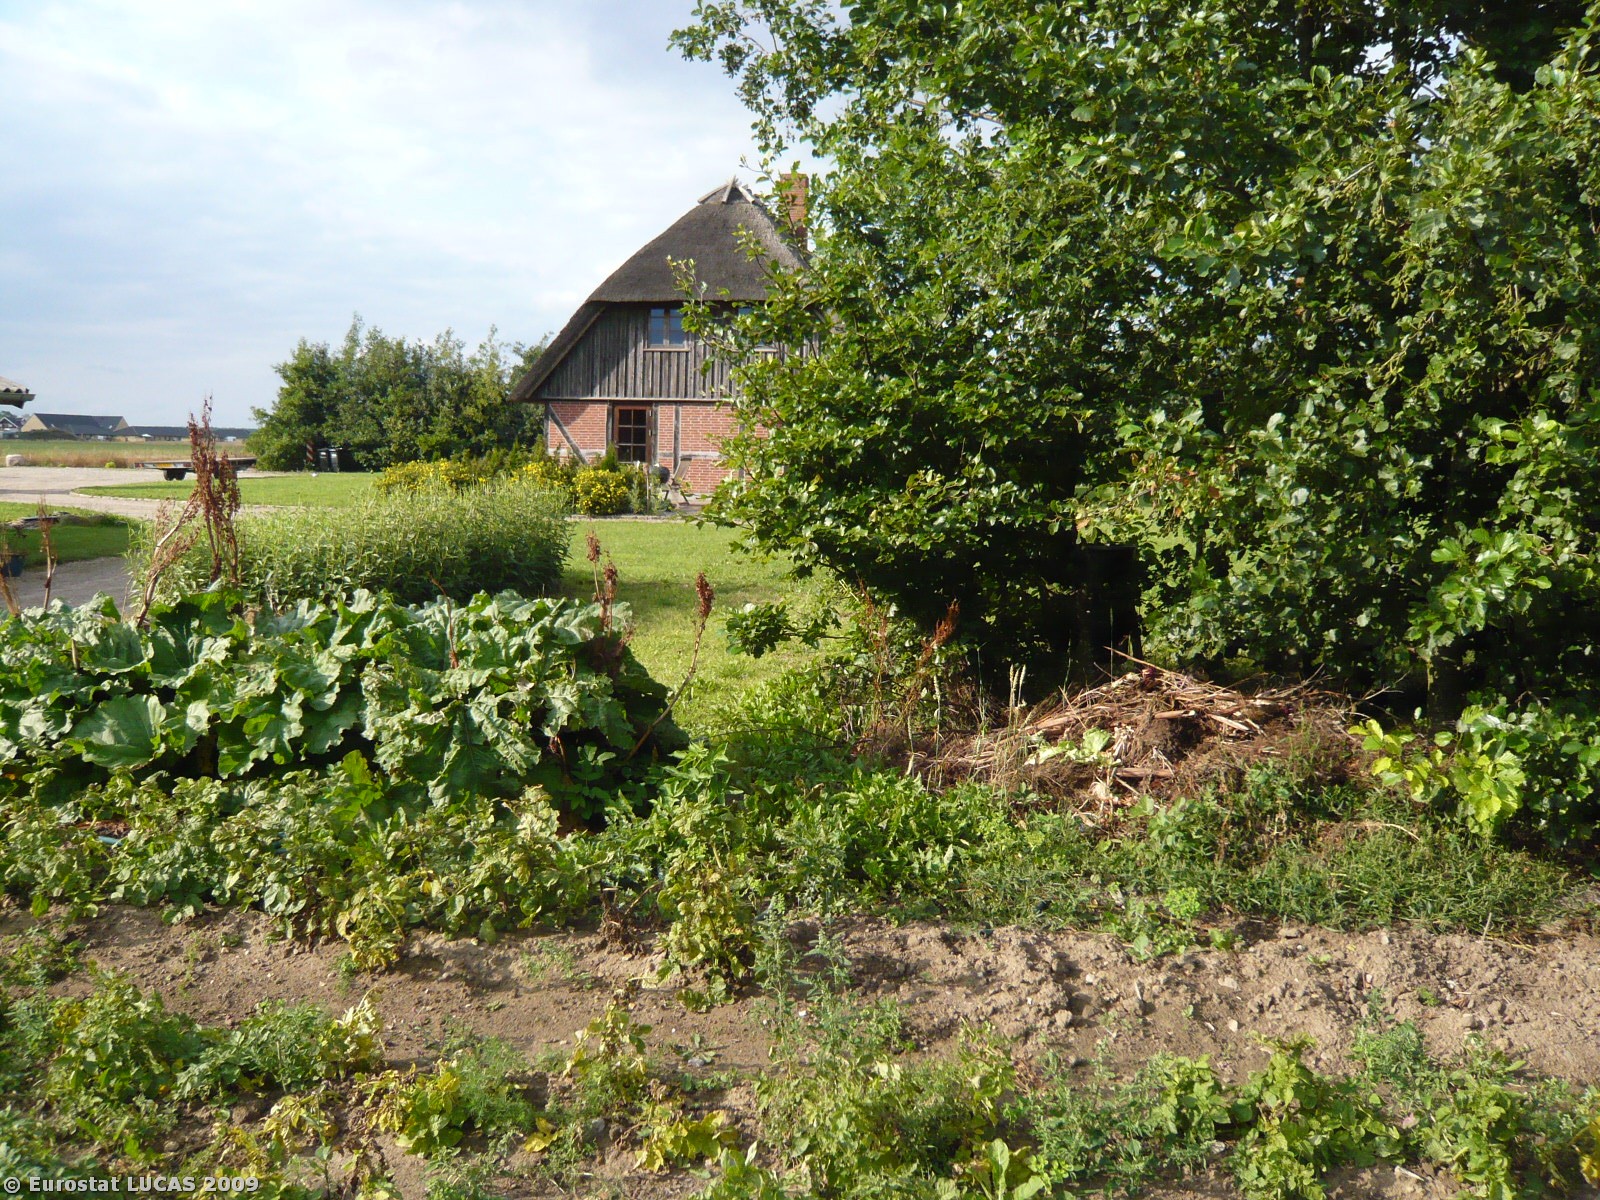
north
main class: Cropland
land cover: Barley
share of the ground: < 10 %
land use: Agriculture (excluding fallow land and kitchen gardens)
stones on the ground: 10 - 25 %
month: May
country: DK
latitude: 55.2974
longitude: 11.5580
